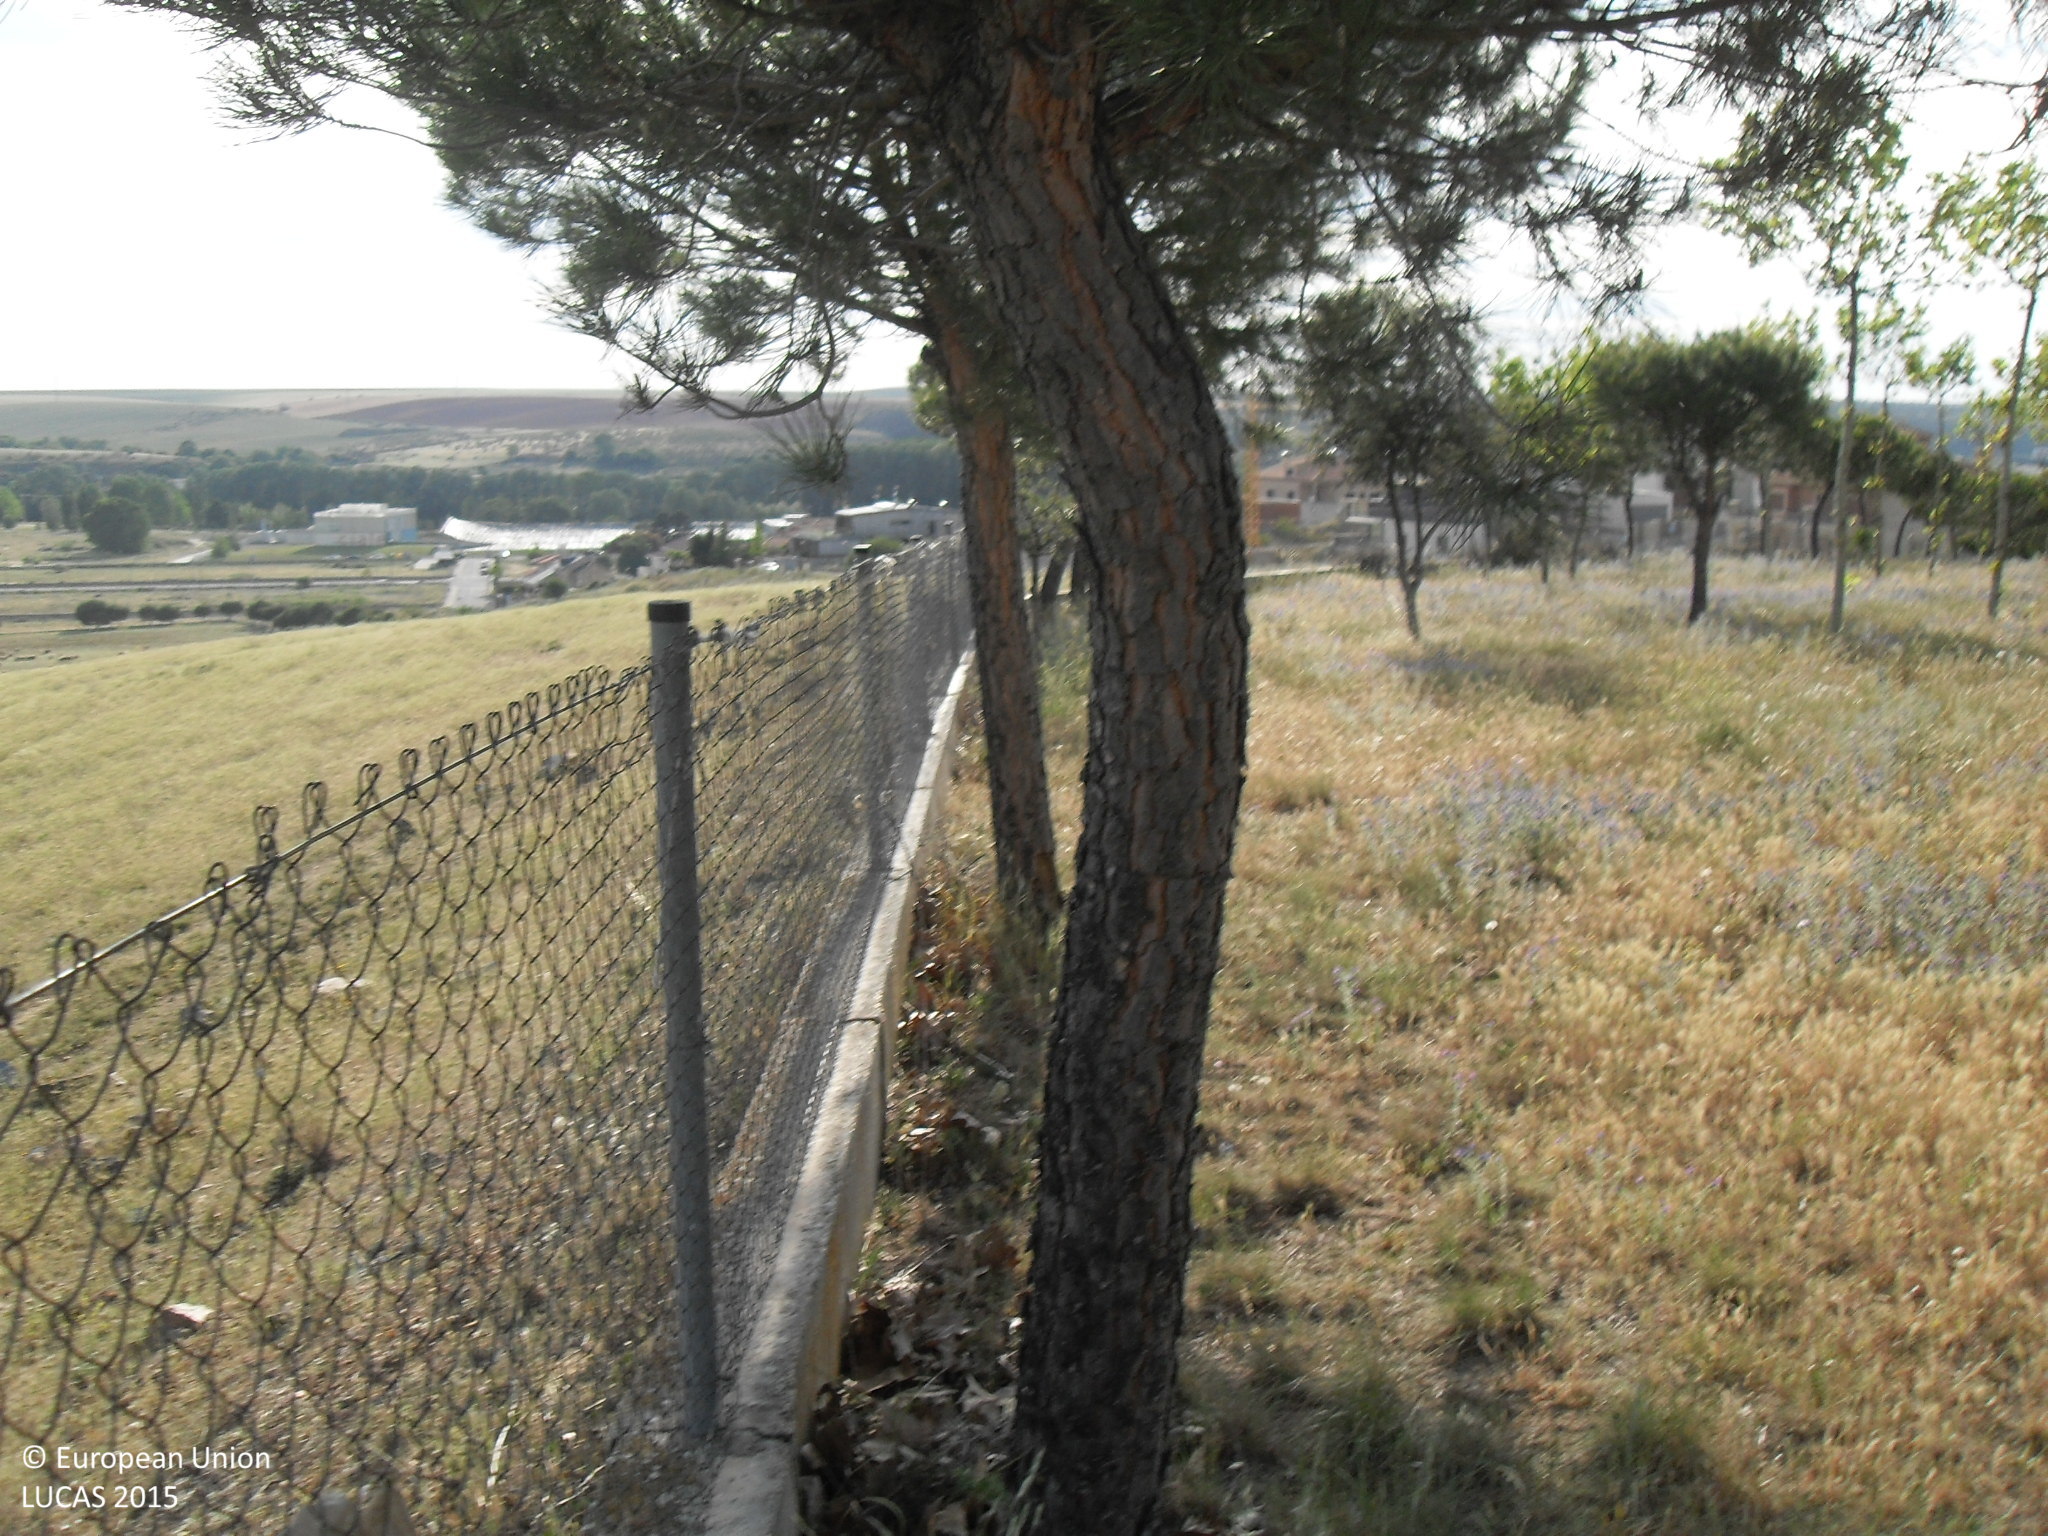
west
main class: Grassland
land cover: Grassland without tree/shrub cover
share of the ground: > 75 %
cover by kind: herbaceous plants 100 %
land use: Agriculture (excluding fallow land and kitchen gardens)
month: May
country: ES
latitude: 40.9788
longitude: -5.7066
